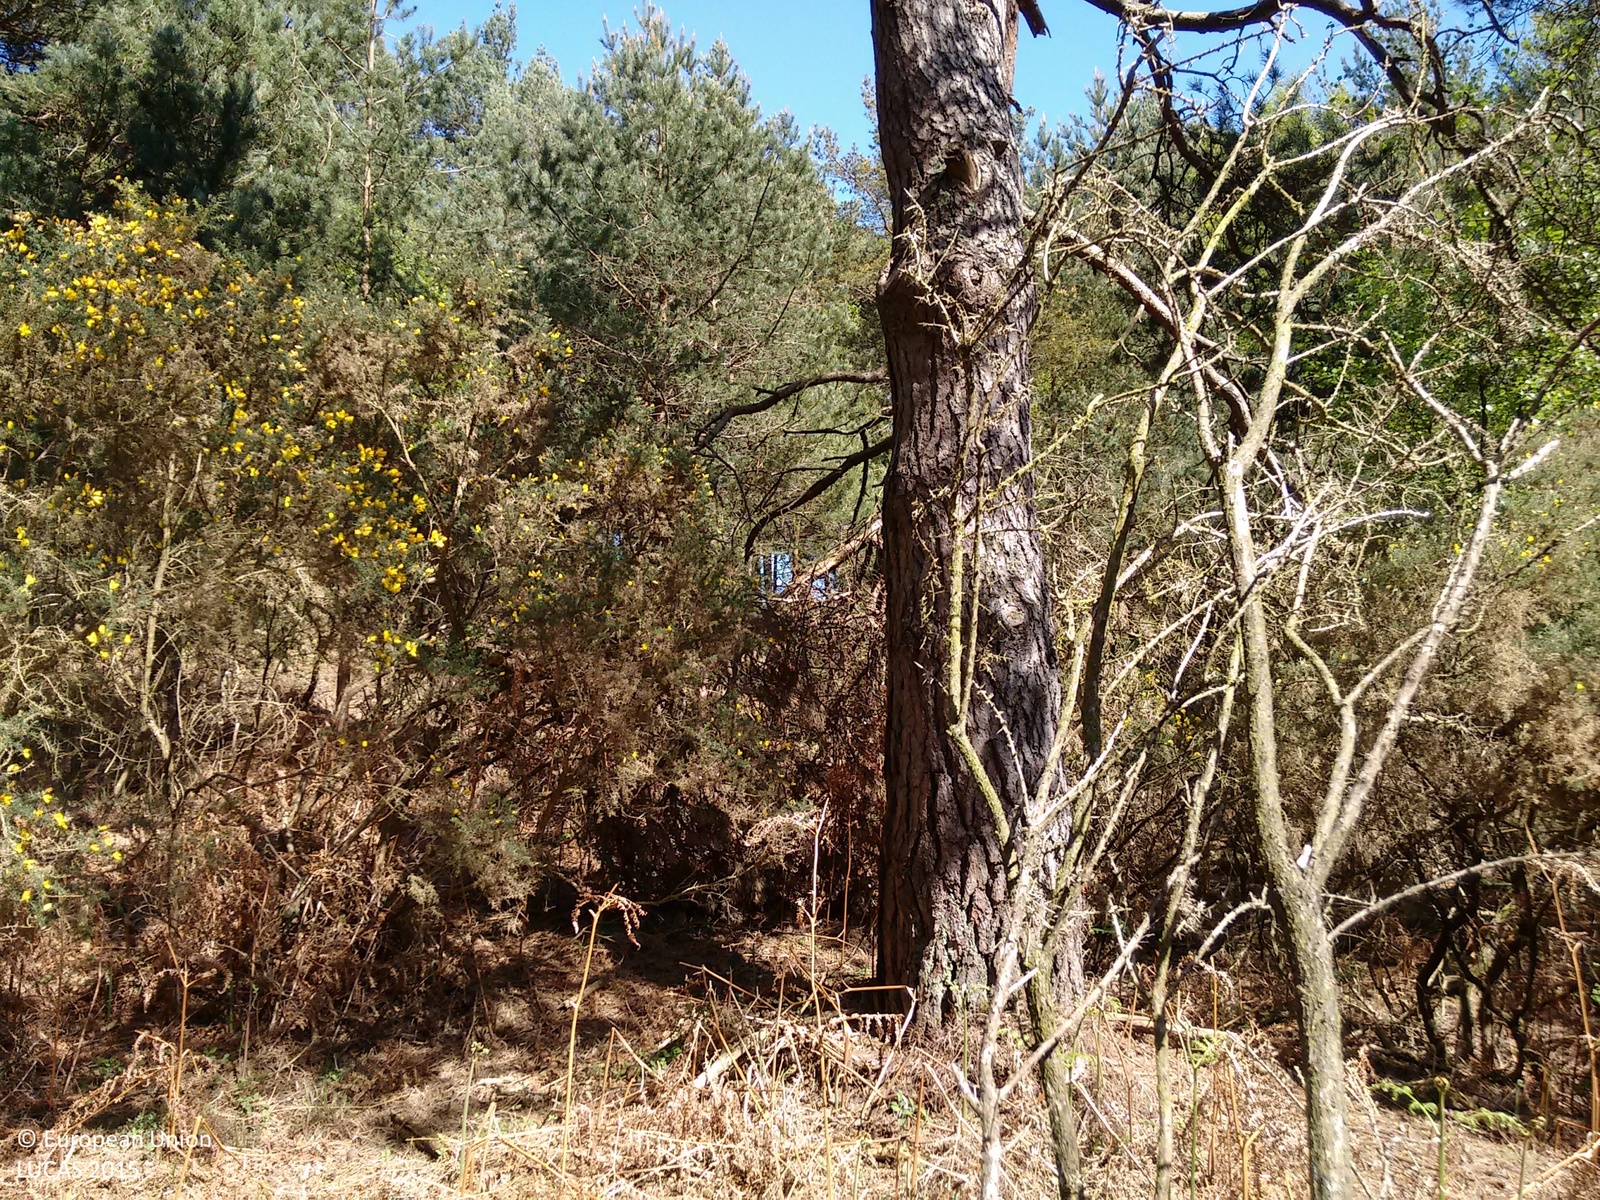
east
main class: Woodland
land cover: Pine dominated mixed woodland
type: hemiboreal forest and nemoral coniferous forest and mixed broadleaved-coniferous forest
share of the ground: > 75 %
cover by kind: coniferous forest trees 70 %, broadleaved forest trees 25 %, shrubs 5 %
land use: Forestry
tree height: > 5 m
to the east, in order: Pine dominated mixed woodland; Grassland with sparse tree/shrub cover; Pine dominated mixed woodland; Grassland with sparse tree/shrub cover; Shrubland with sparse tree cover
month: May
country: GB
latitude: 50.6469
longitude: -2.0947
